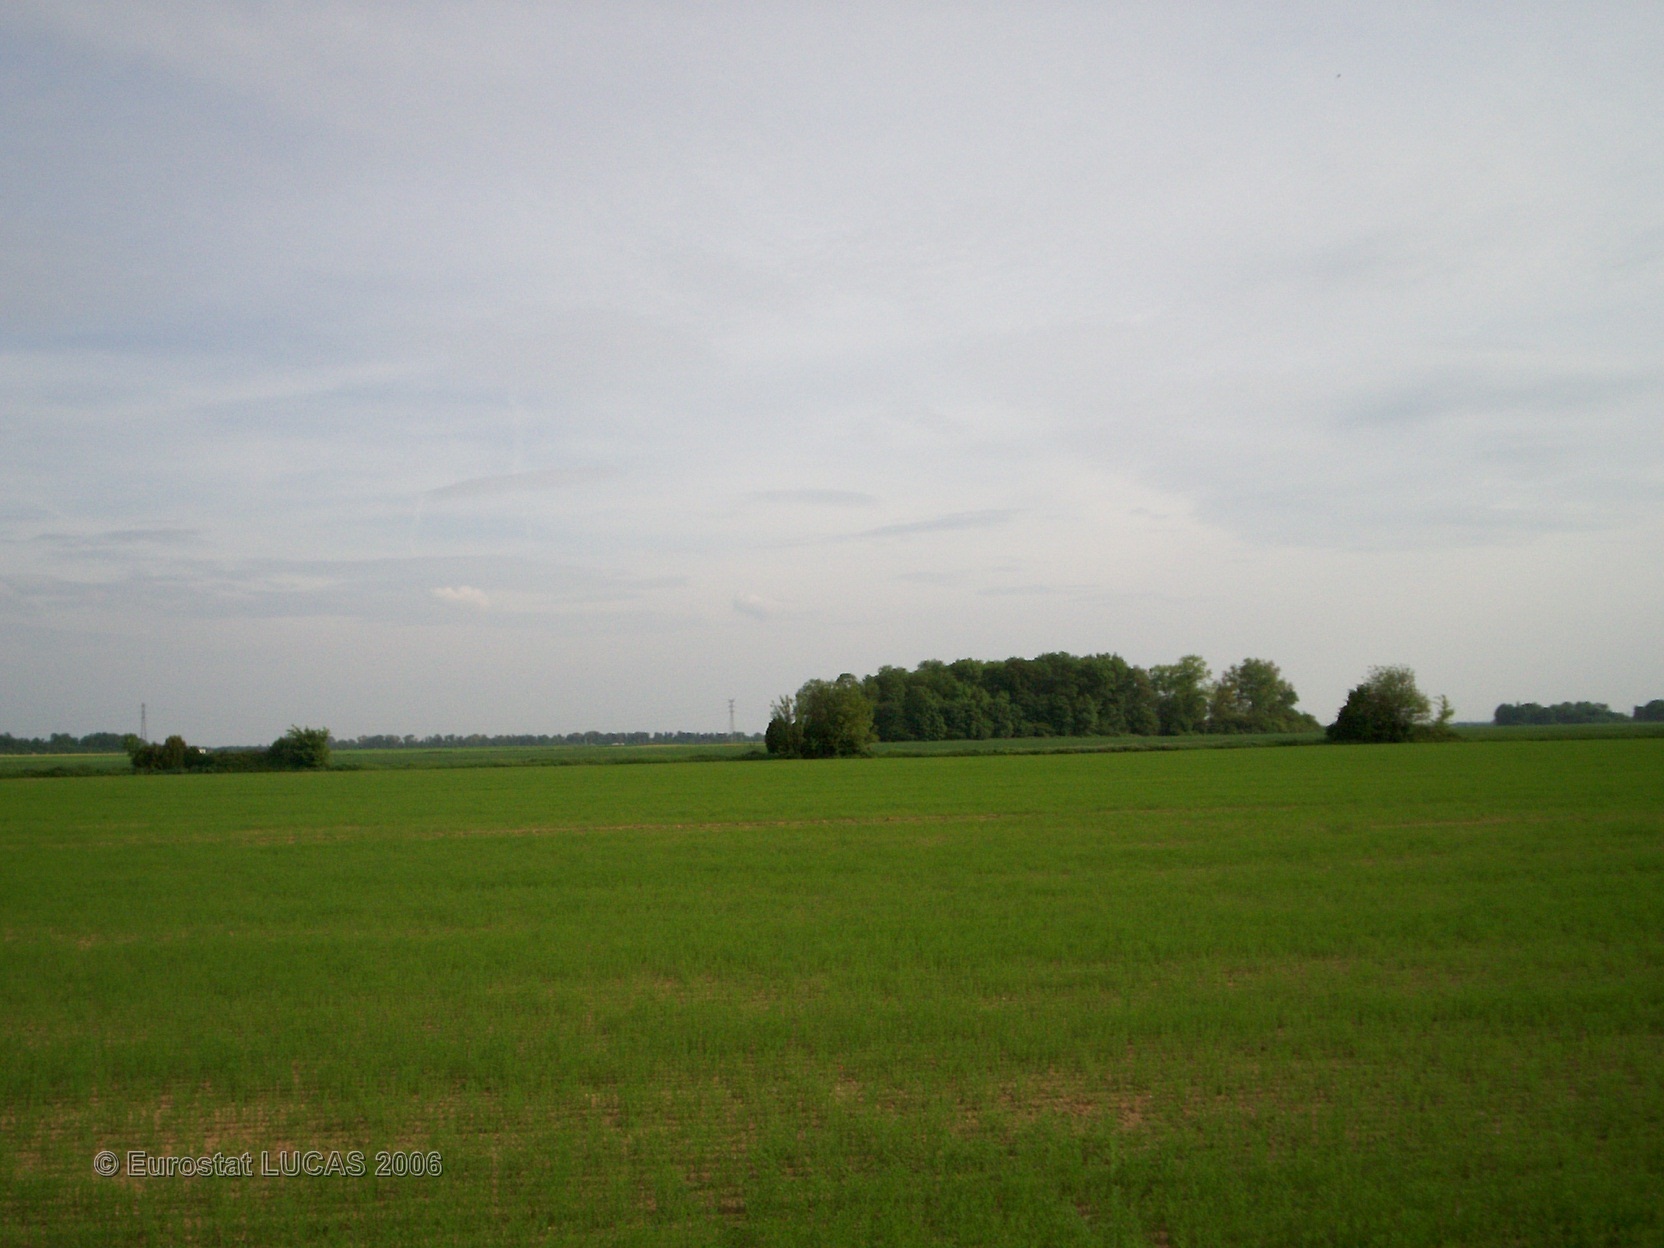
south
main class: Cropland
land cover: Other fibre and oleaginous crops
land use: Agriculture (excluding fallow land and kitchen gardens)
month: May
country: FR
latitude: 48.6015
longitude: 2.7899
